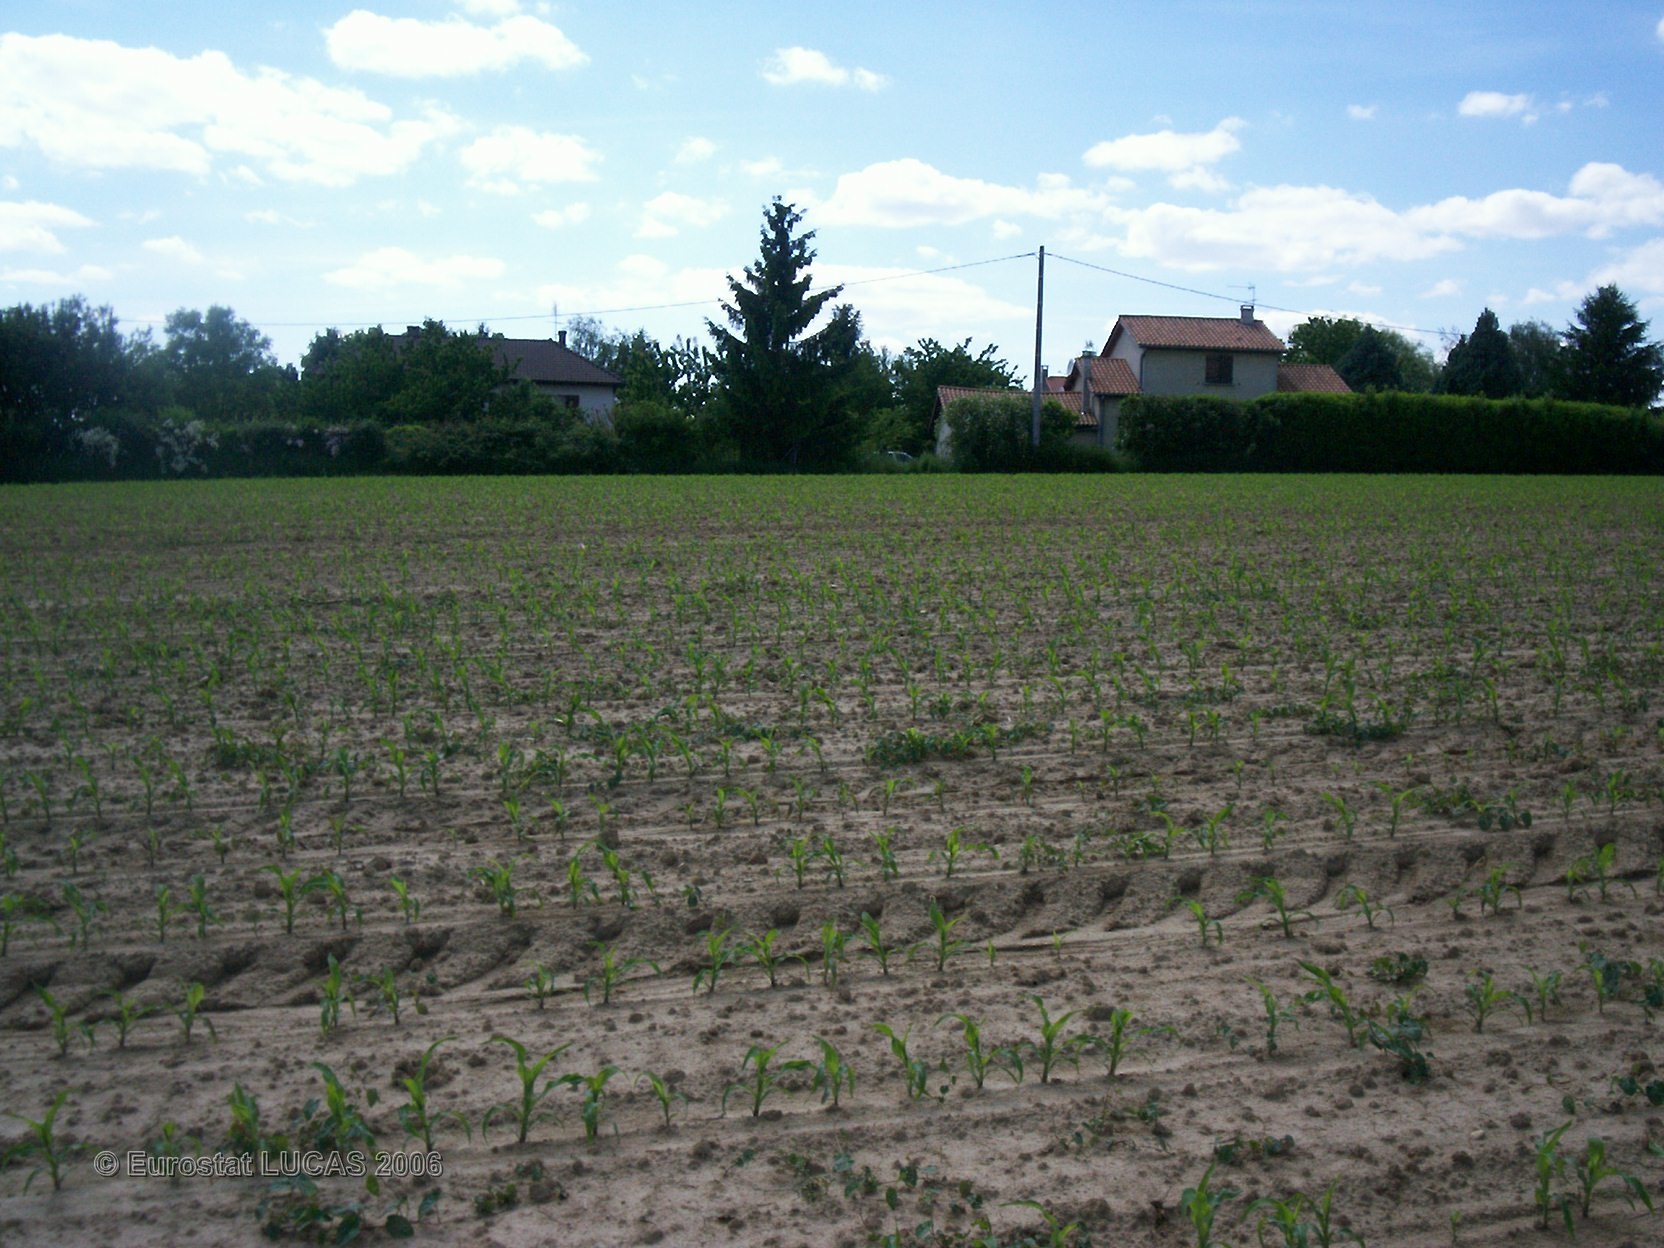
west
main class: Cropland
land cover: Maize
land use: Agriculture (excluding fallow land and kitchen gardens)
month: May
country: FR
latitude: 45.9579
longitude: 4.8808
